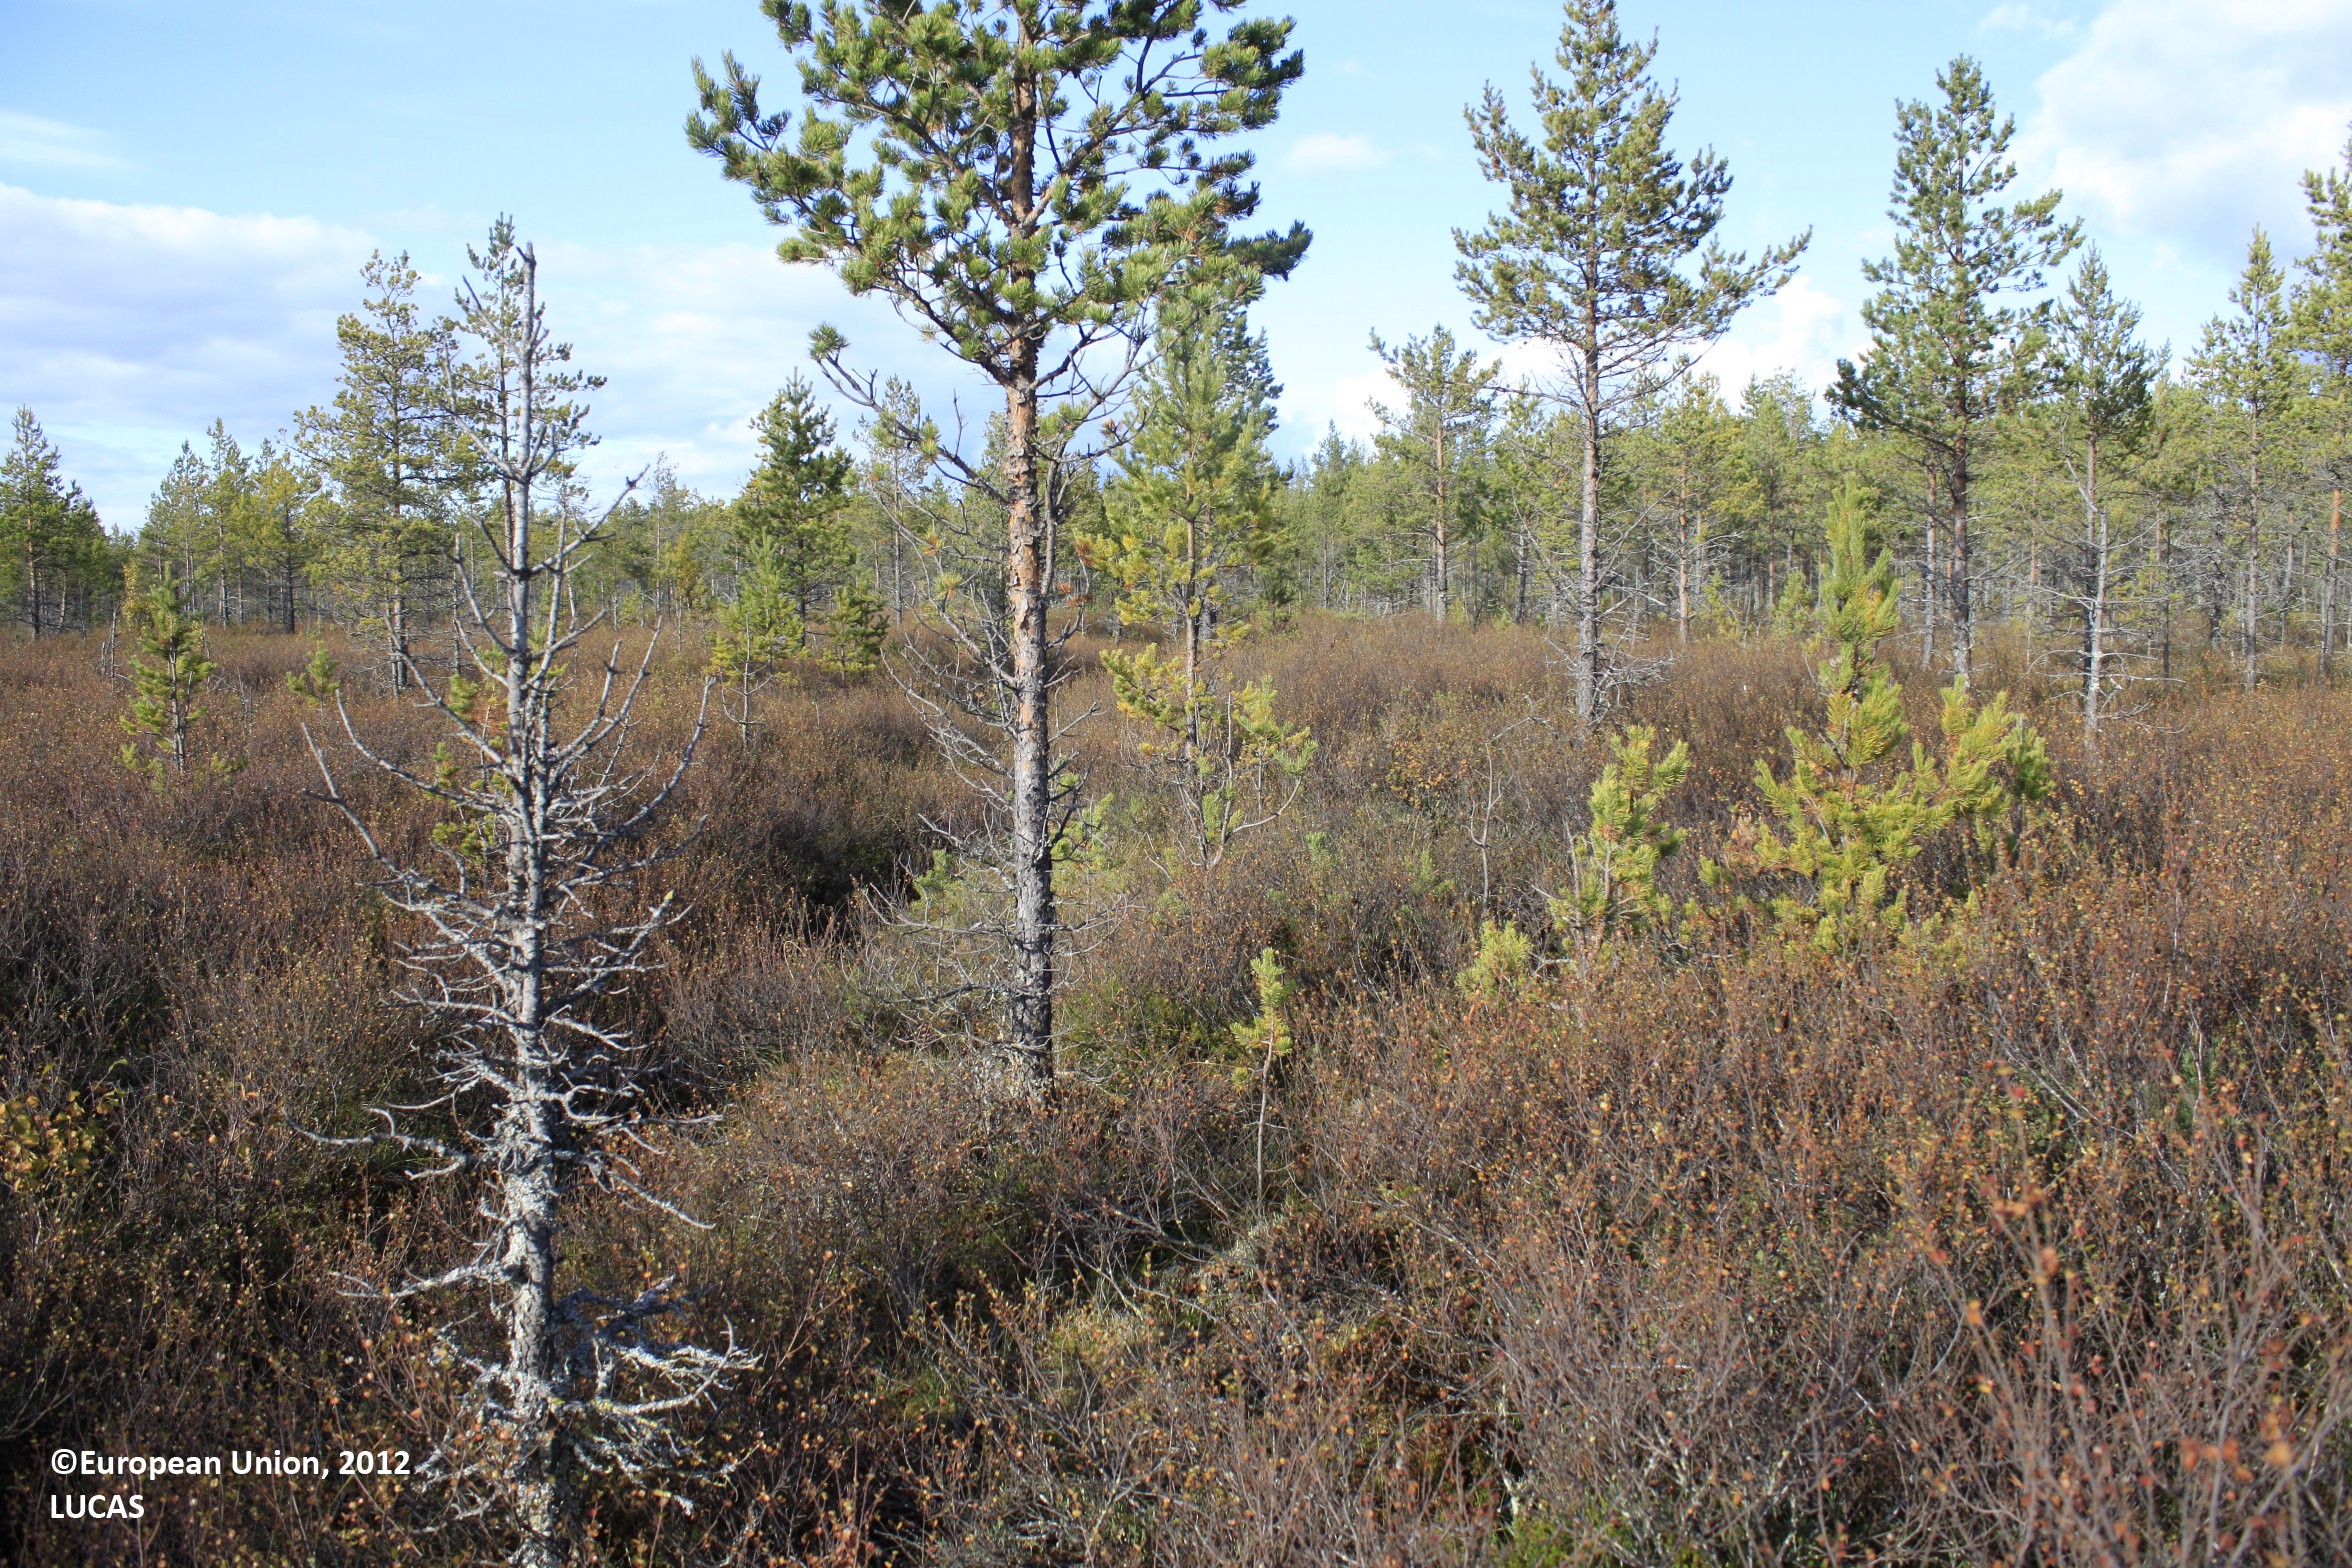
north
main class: Woodland
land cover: Pine dominated coniferous woodland
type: mire and swamp forests
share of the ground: 10 - 25 %
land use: Forestry
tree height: < 5 m
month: September
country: FI
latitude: 65.4712
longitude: 27.0632
